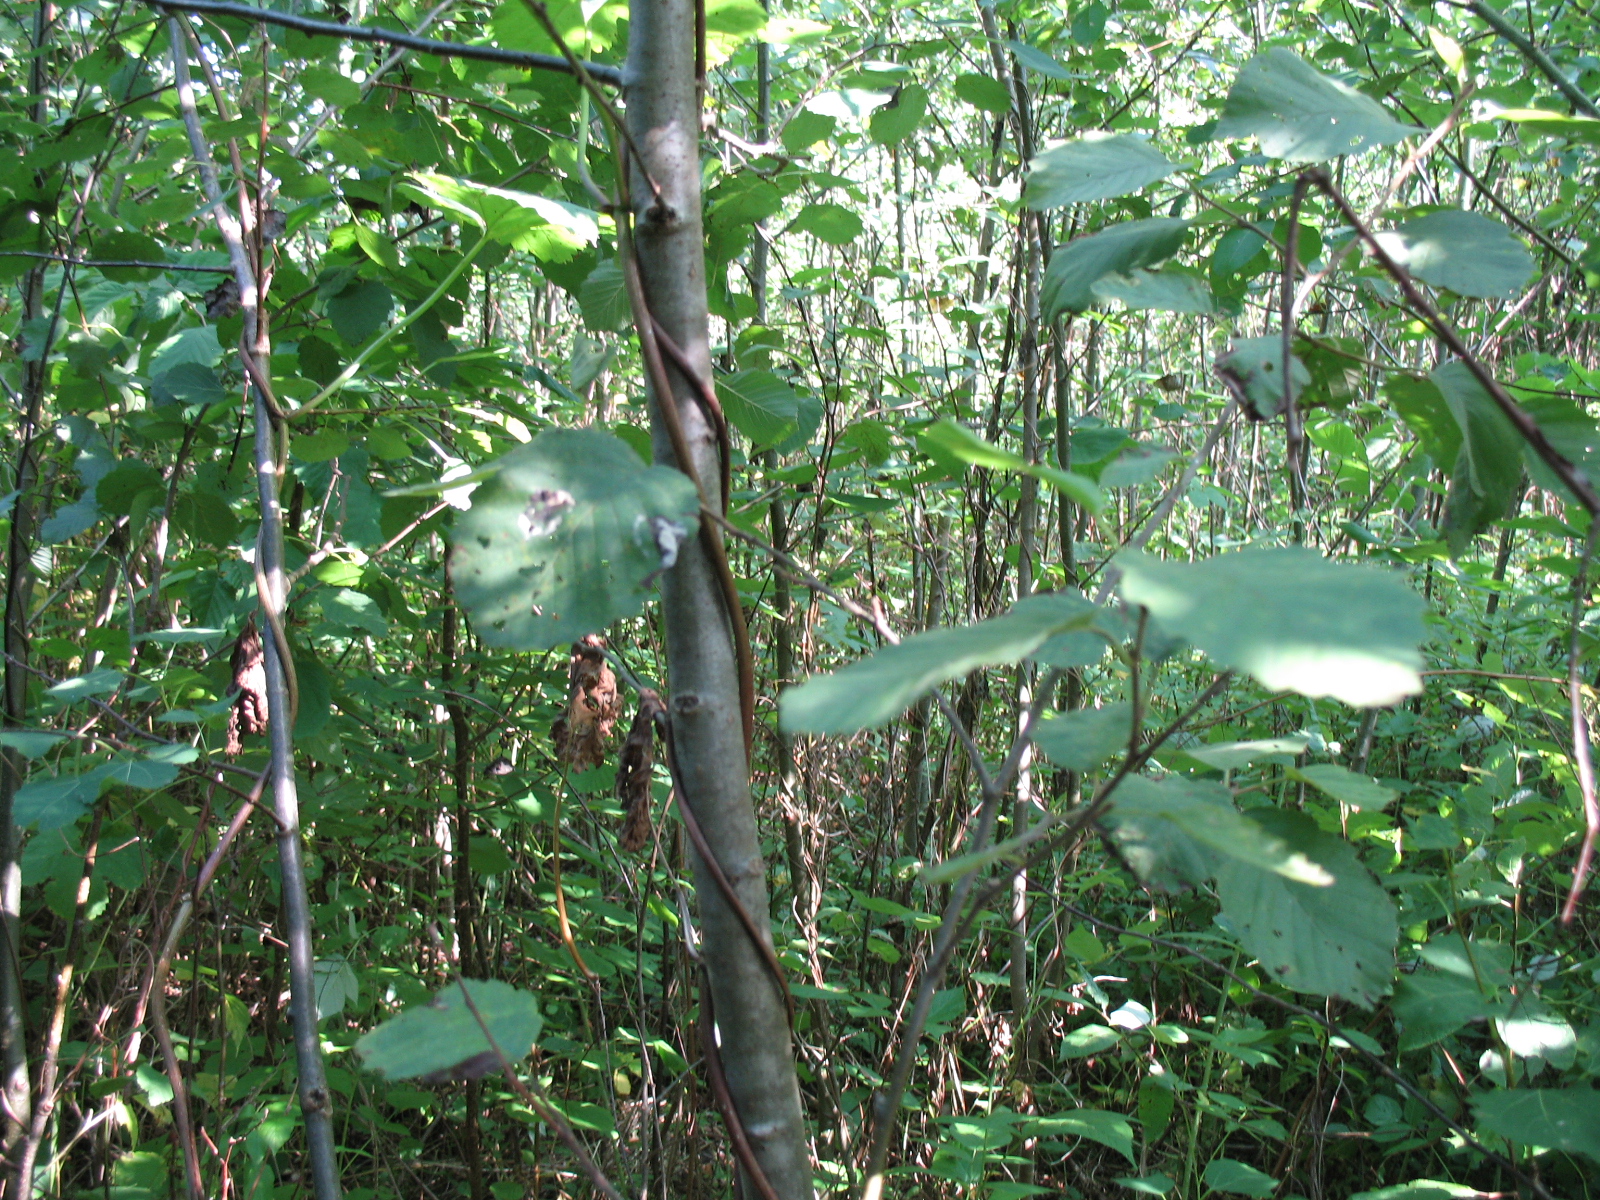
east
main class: Woodland
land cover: Spruce dominated mixed woodland
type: hemiboreal forest and nemoral coniferous forest and mixed broadleaved-coniferous forest
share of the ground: > 75 %
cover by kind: broadleaved forest trees 65 %, coniferous forest trees 30 %, herbaceous plants 5 %
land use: Forestry
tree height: > 5 m
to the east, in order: Spruce dominated mixed woodland; Broadleaved woodland; Spruce dominated mixed woodland; Ditches and canals; Broadleaved woodland; Spontaneously vegetated surfaces; Broadleaved woodland
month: August
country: LV
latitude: 56.2020
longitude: 25.4163
